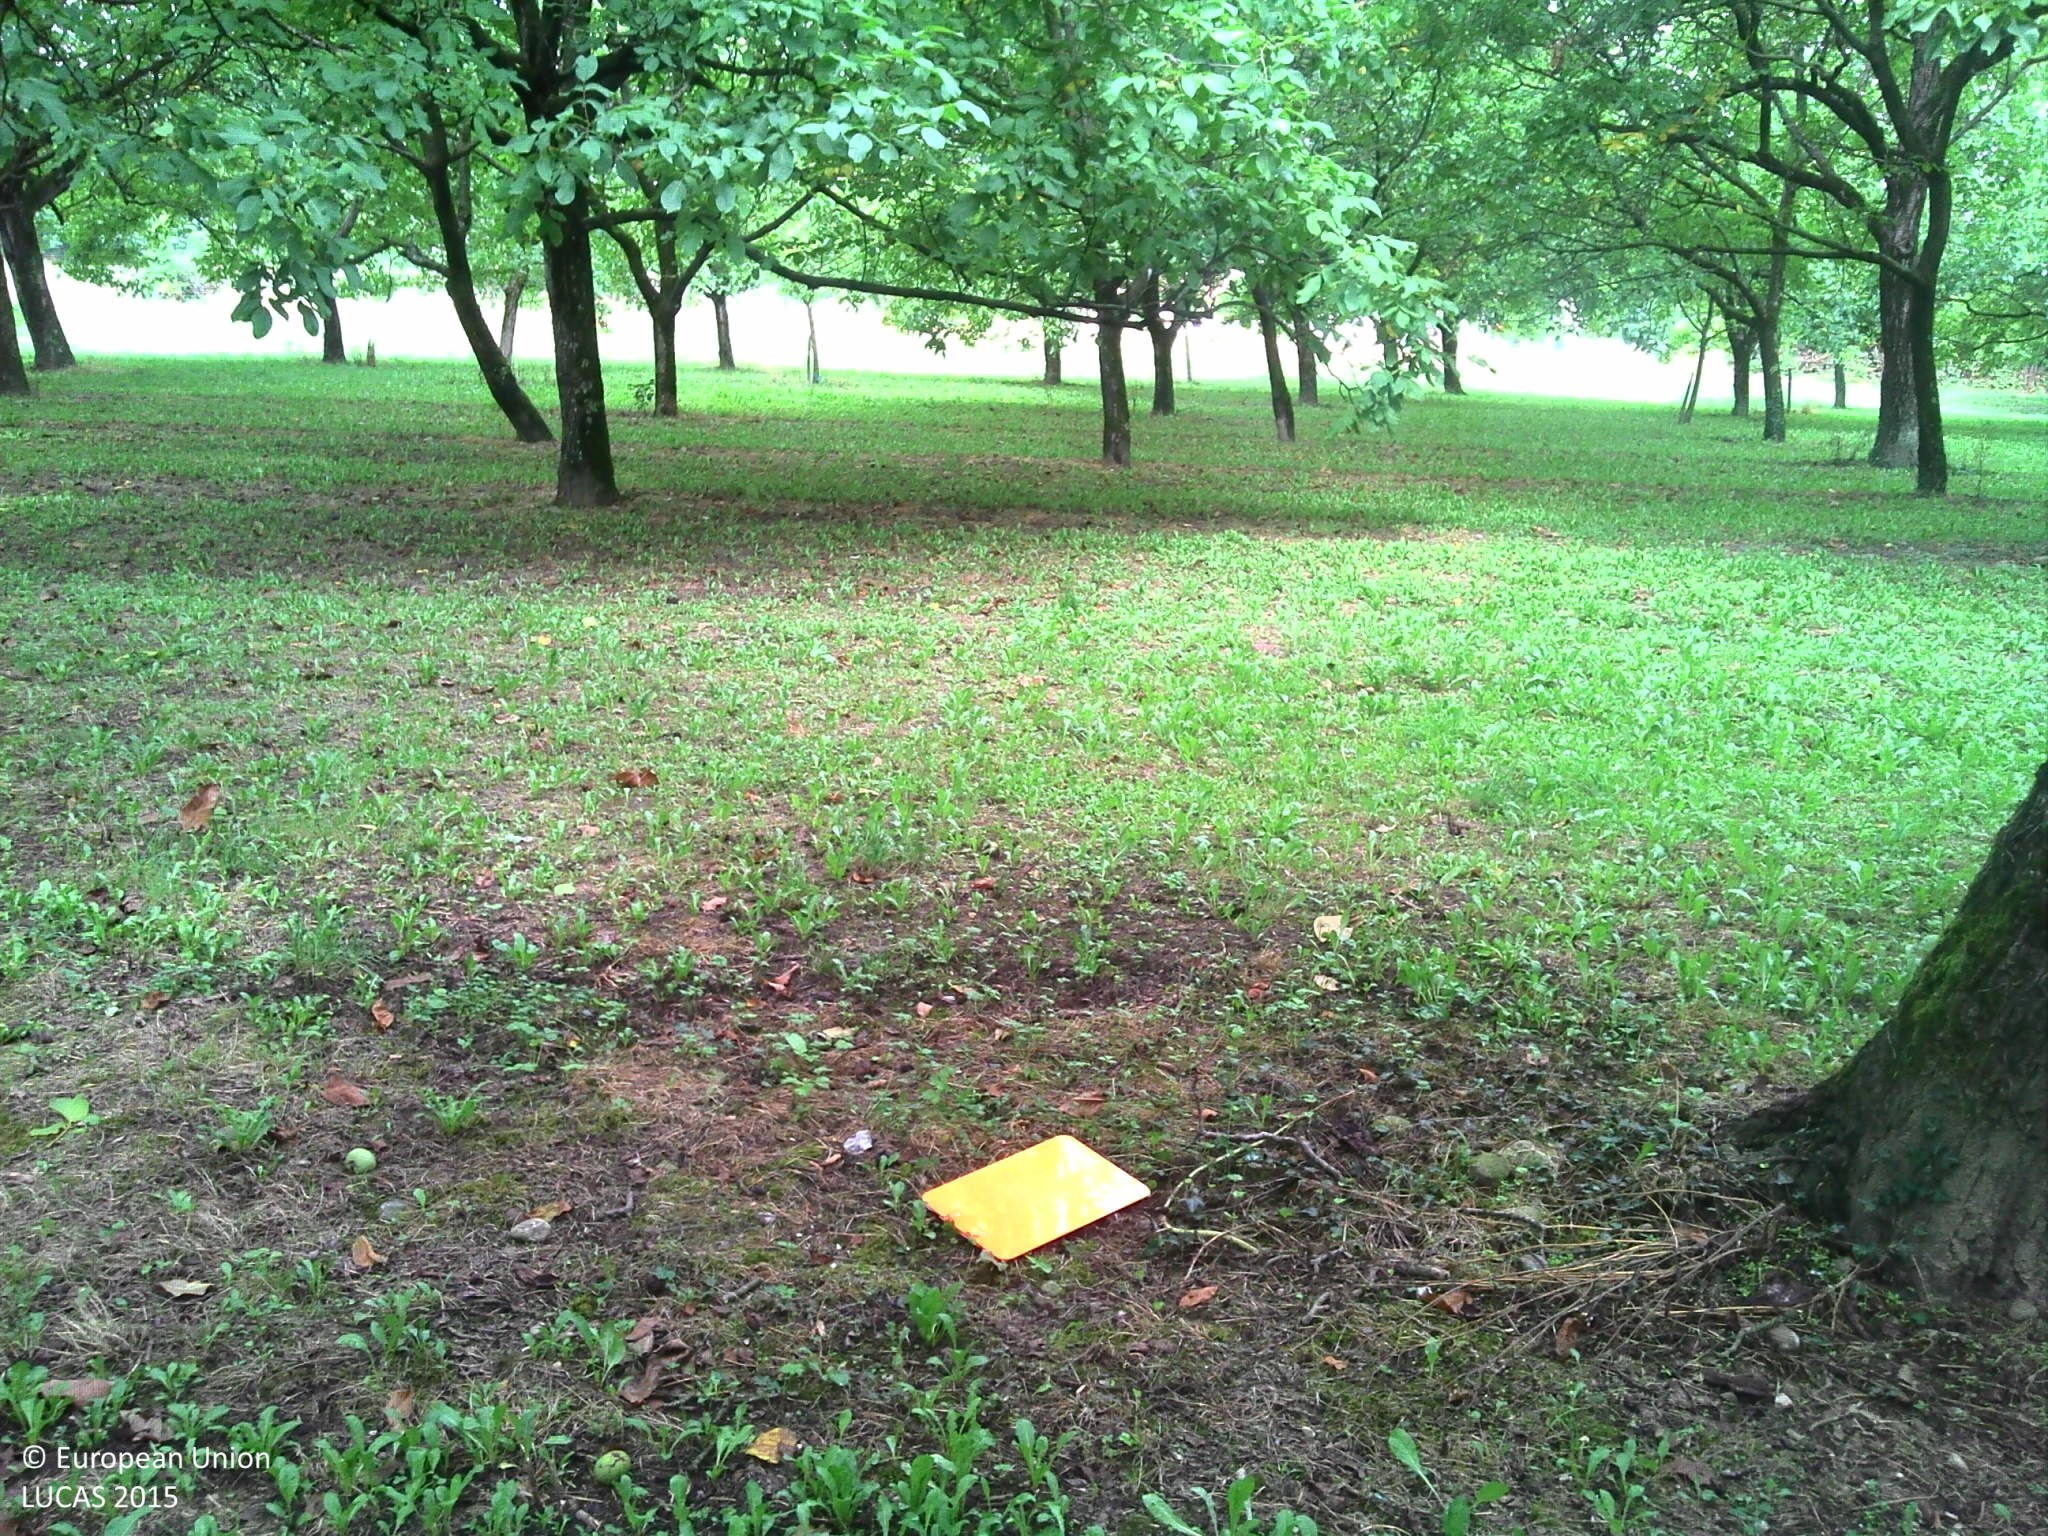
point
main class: Cropland
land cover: Nuts trees
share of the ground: 50 - 75 %
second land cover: Spontaneously vegetated surfaces
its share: > 75 %
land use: Agriculture (excluding fallow land and kitchen gardens)
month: August
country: FR
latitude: 45.3374
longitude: 5.5259
